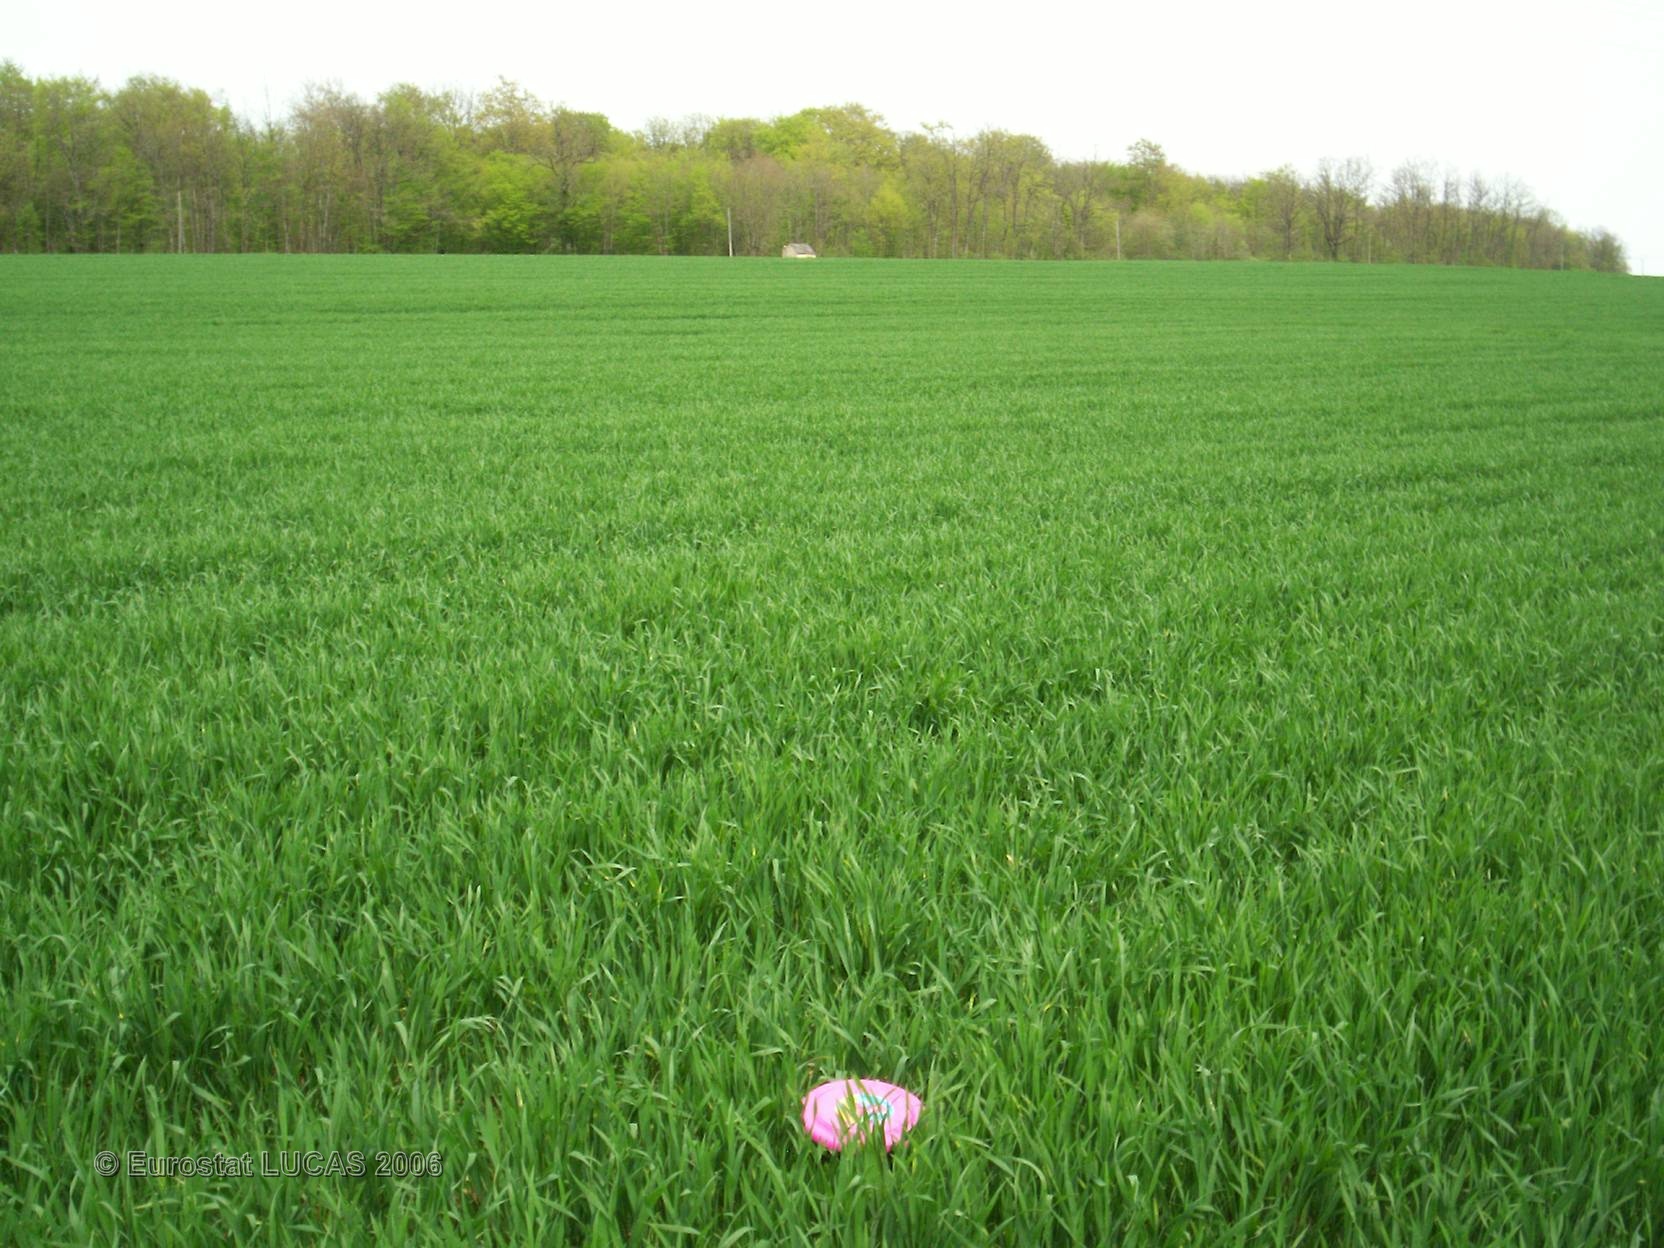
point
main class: Cropland
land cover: Common wheat
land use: Agriculture (excluding fallow land and kitchen gardens)
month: May
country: FR
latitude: 47.6740
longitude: 4.5513
